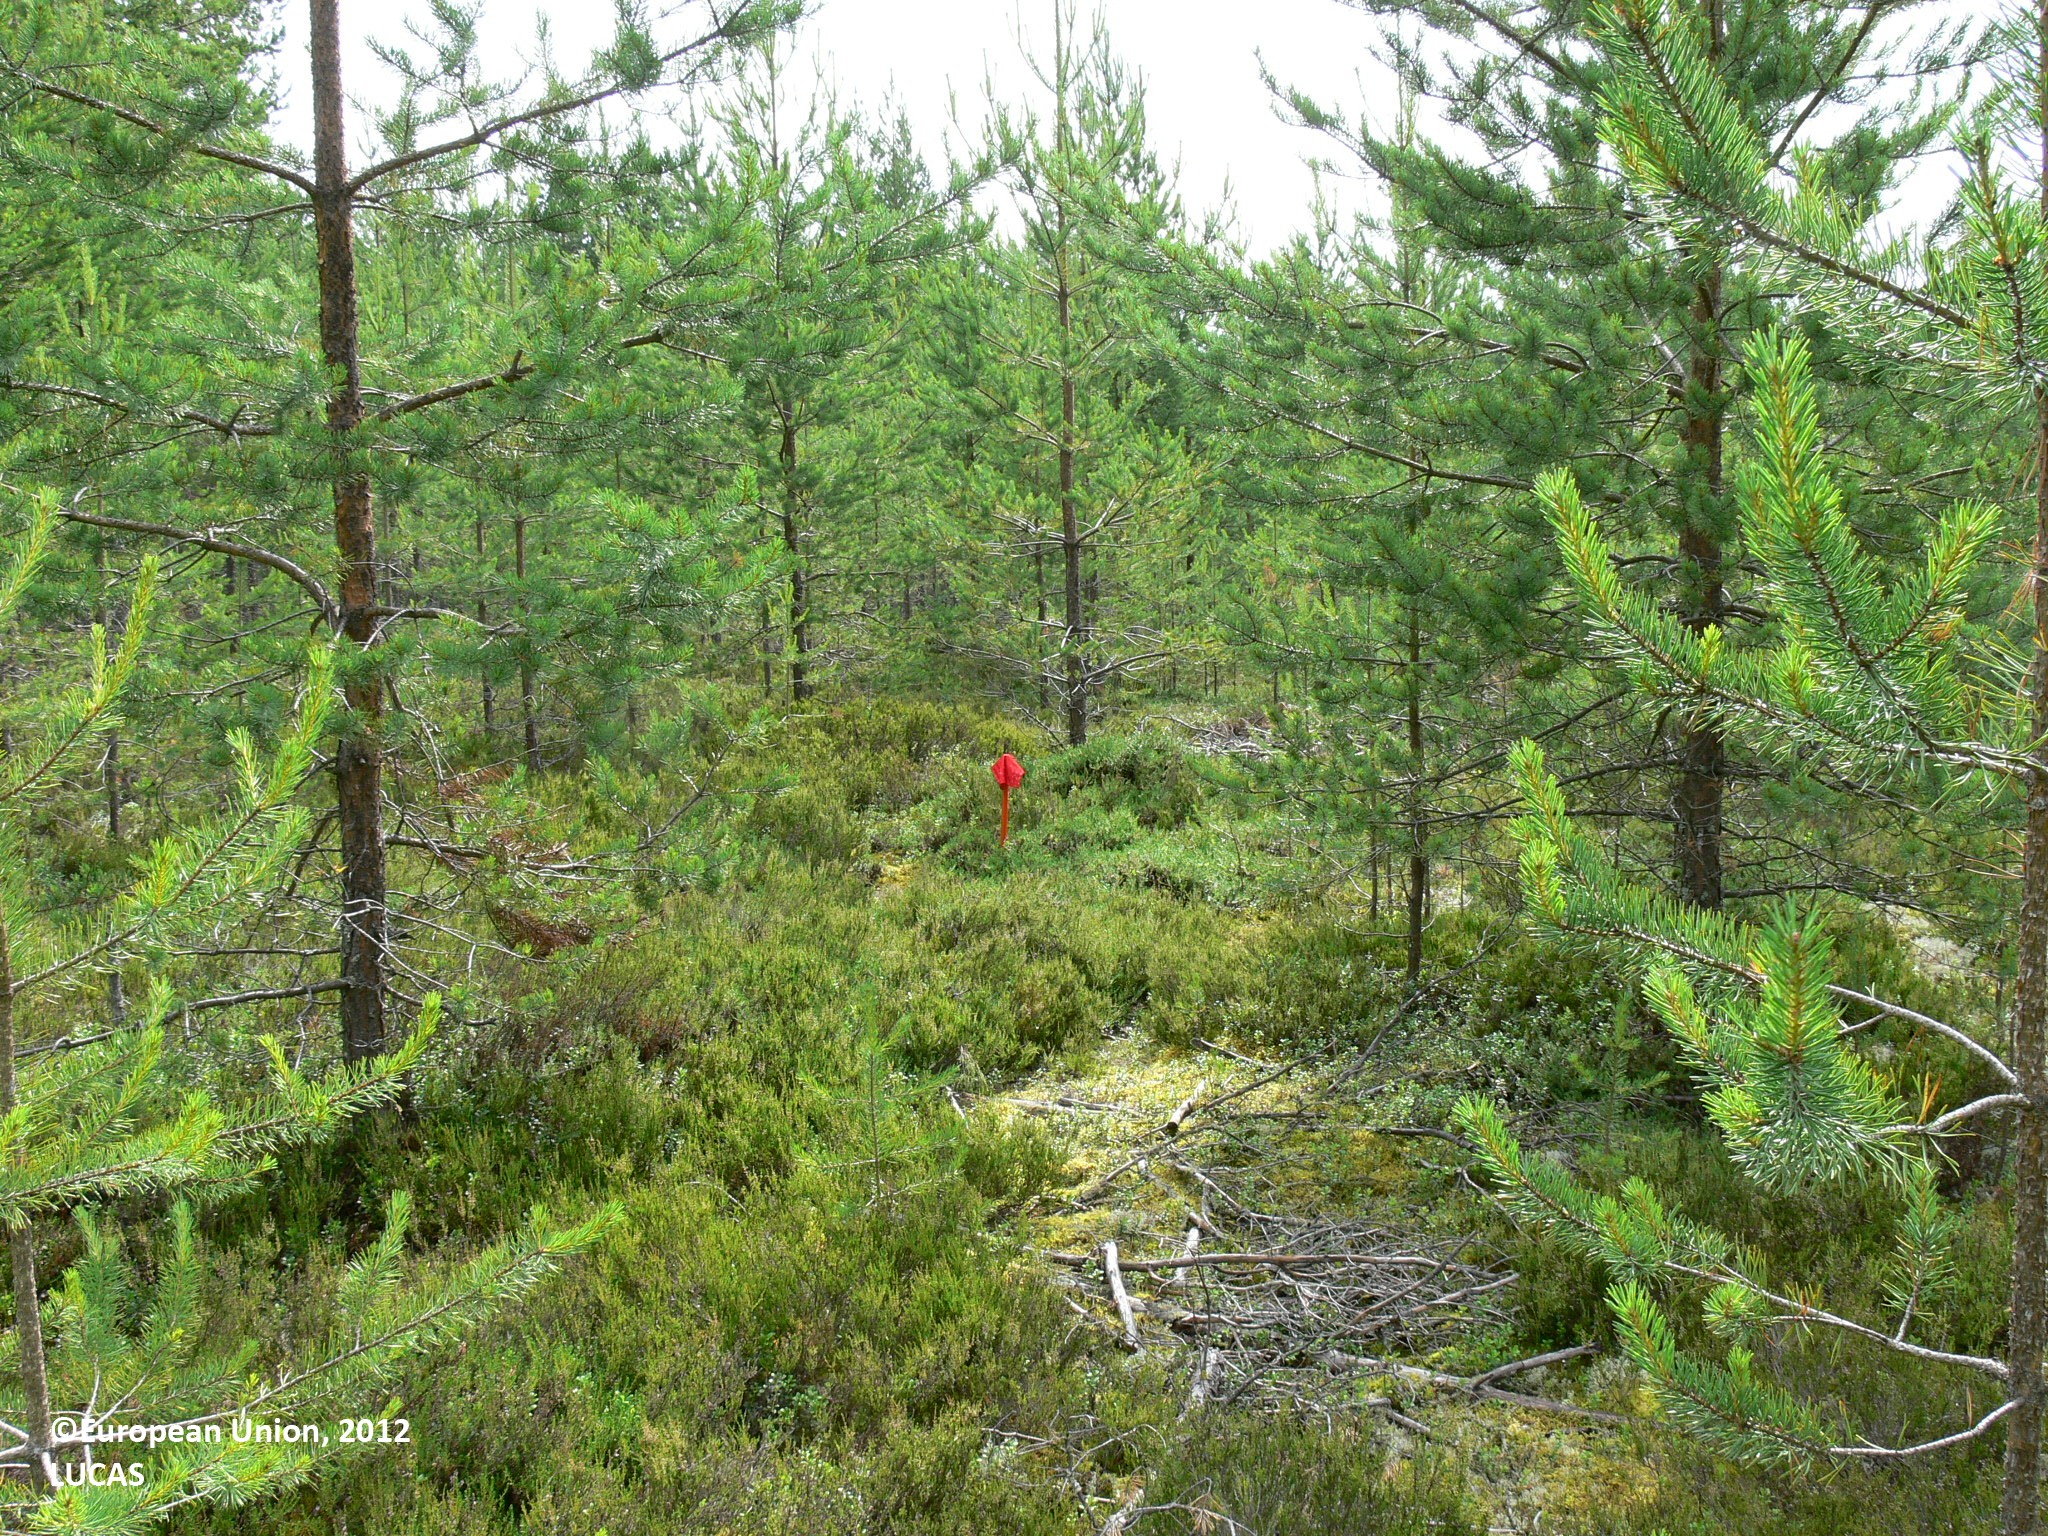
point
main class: Woodland
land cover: Pine dominated coniferous woodland
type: boreal forest
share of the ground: 25 - 50 %
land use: Forestry
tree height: < 5 m
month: July
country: FI
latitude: 63.0835
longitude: 29.9938
